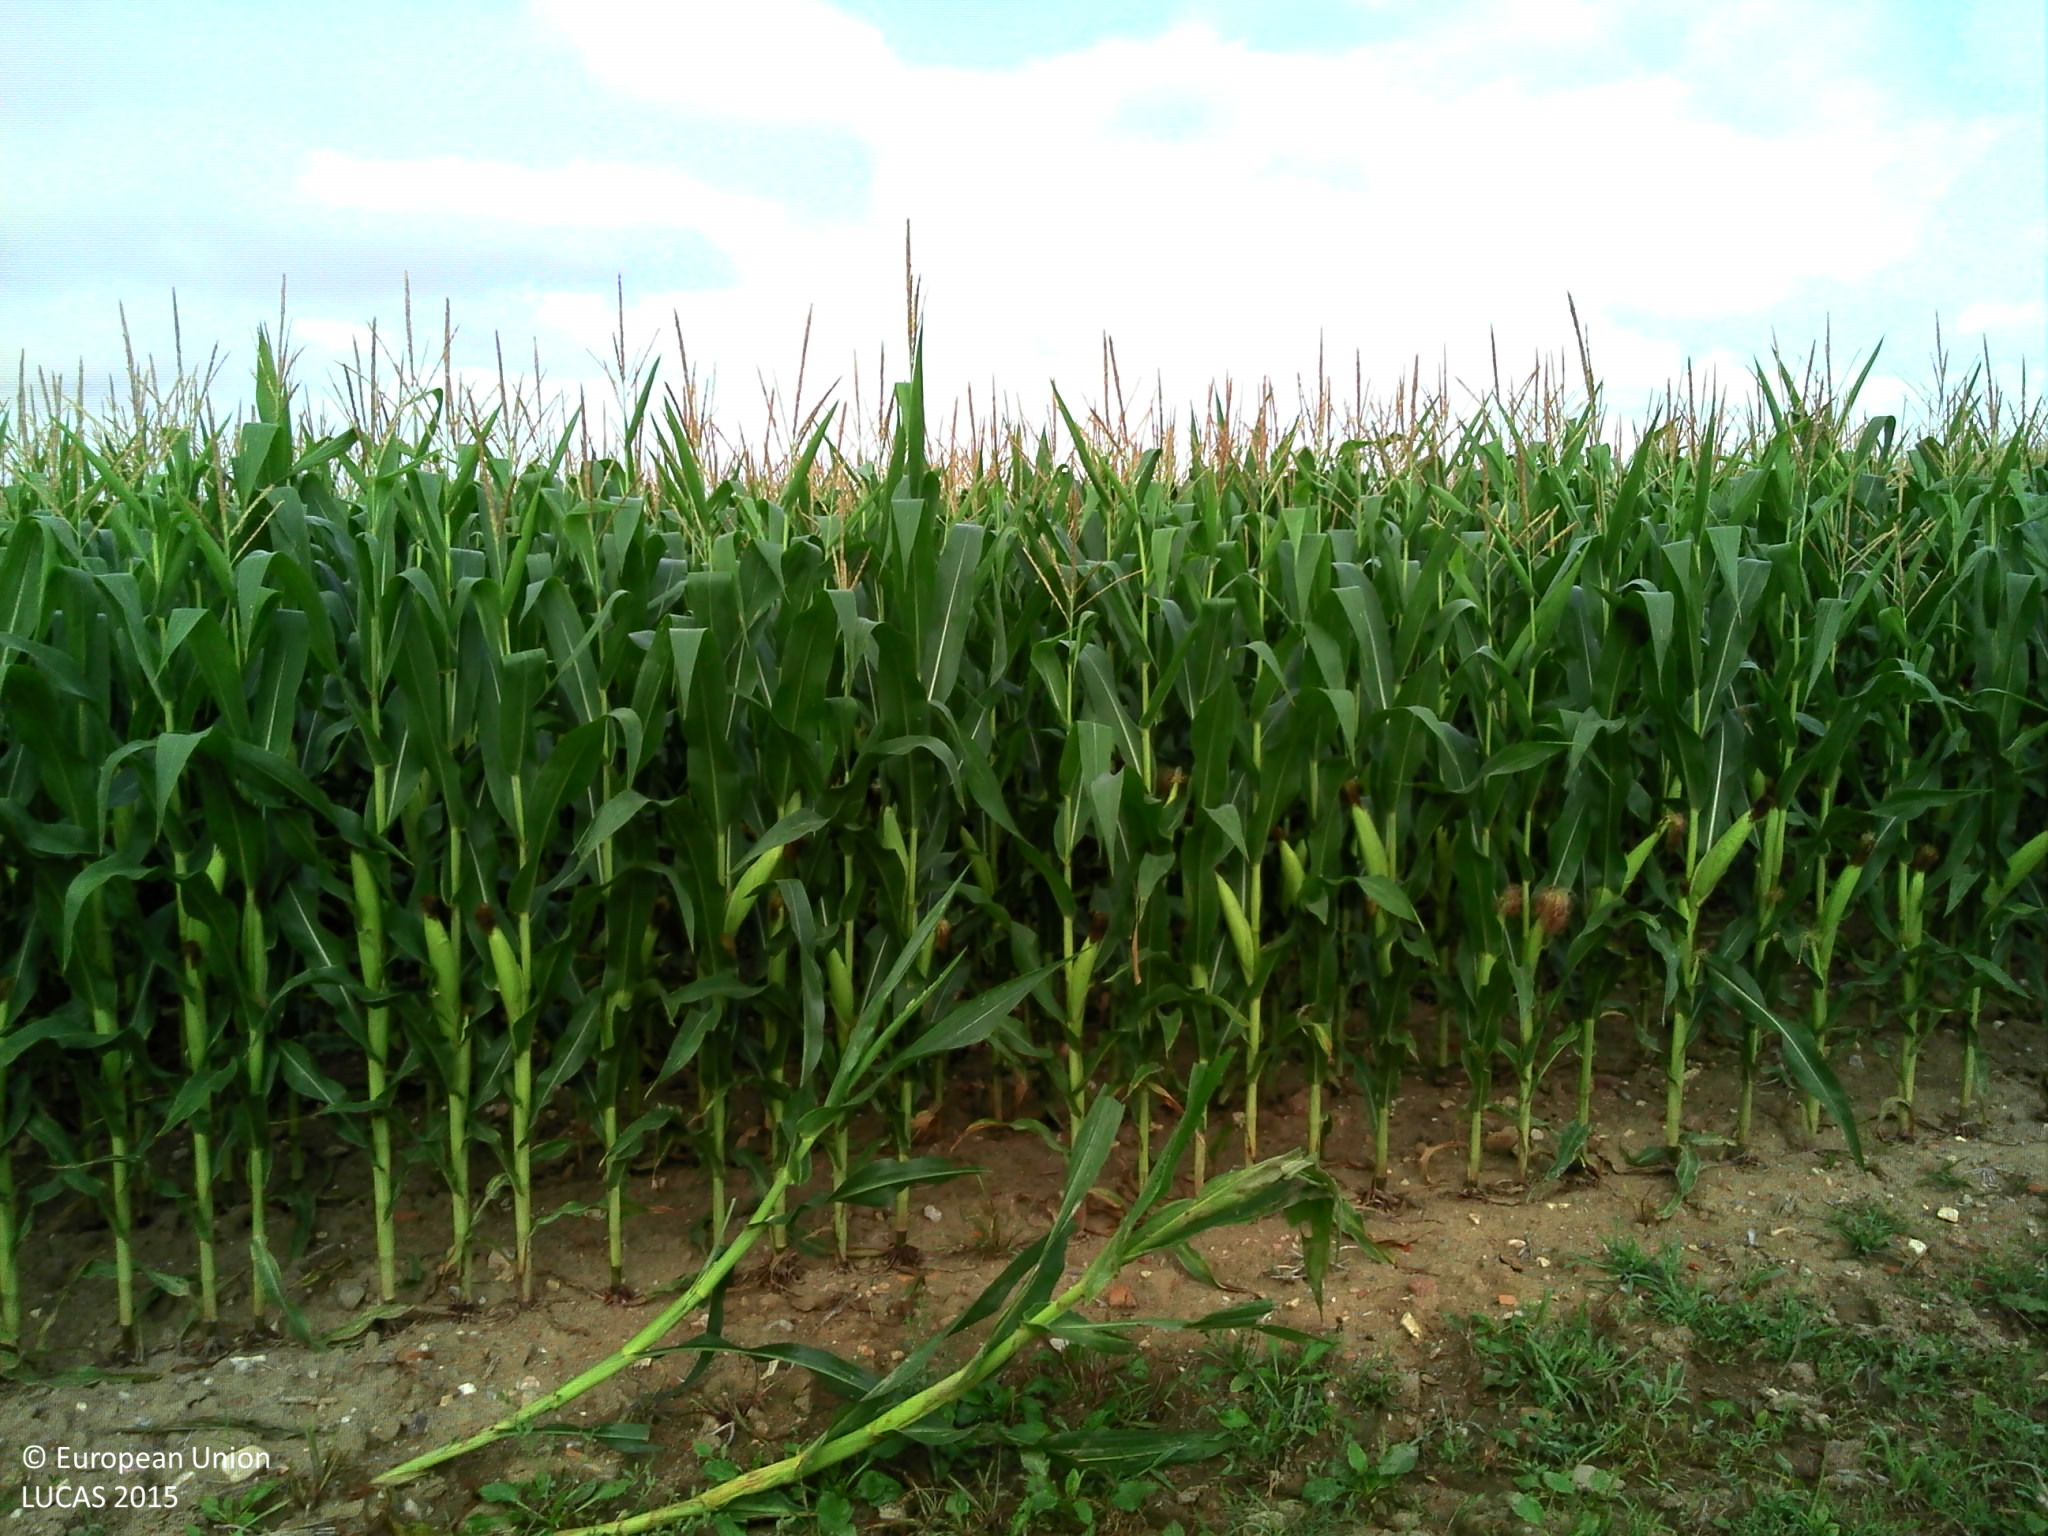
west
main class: Cropland
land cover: Maize
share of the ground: > 75 %
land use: Agriculture (excluding fallow land and kitchen gardens)
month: July
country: FR
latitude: 46.3098
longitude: 0.5174
